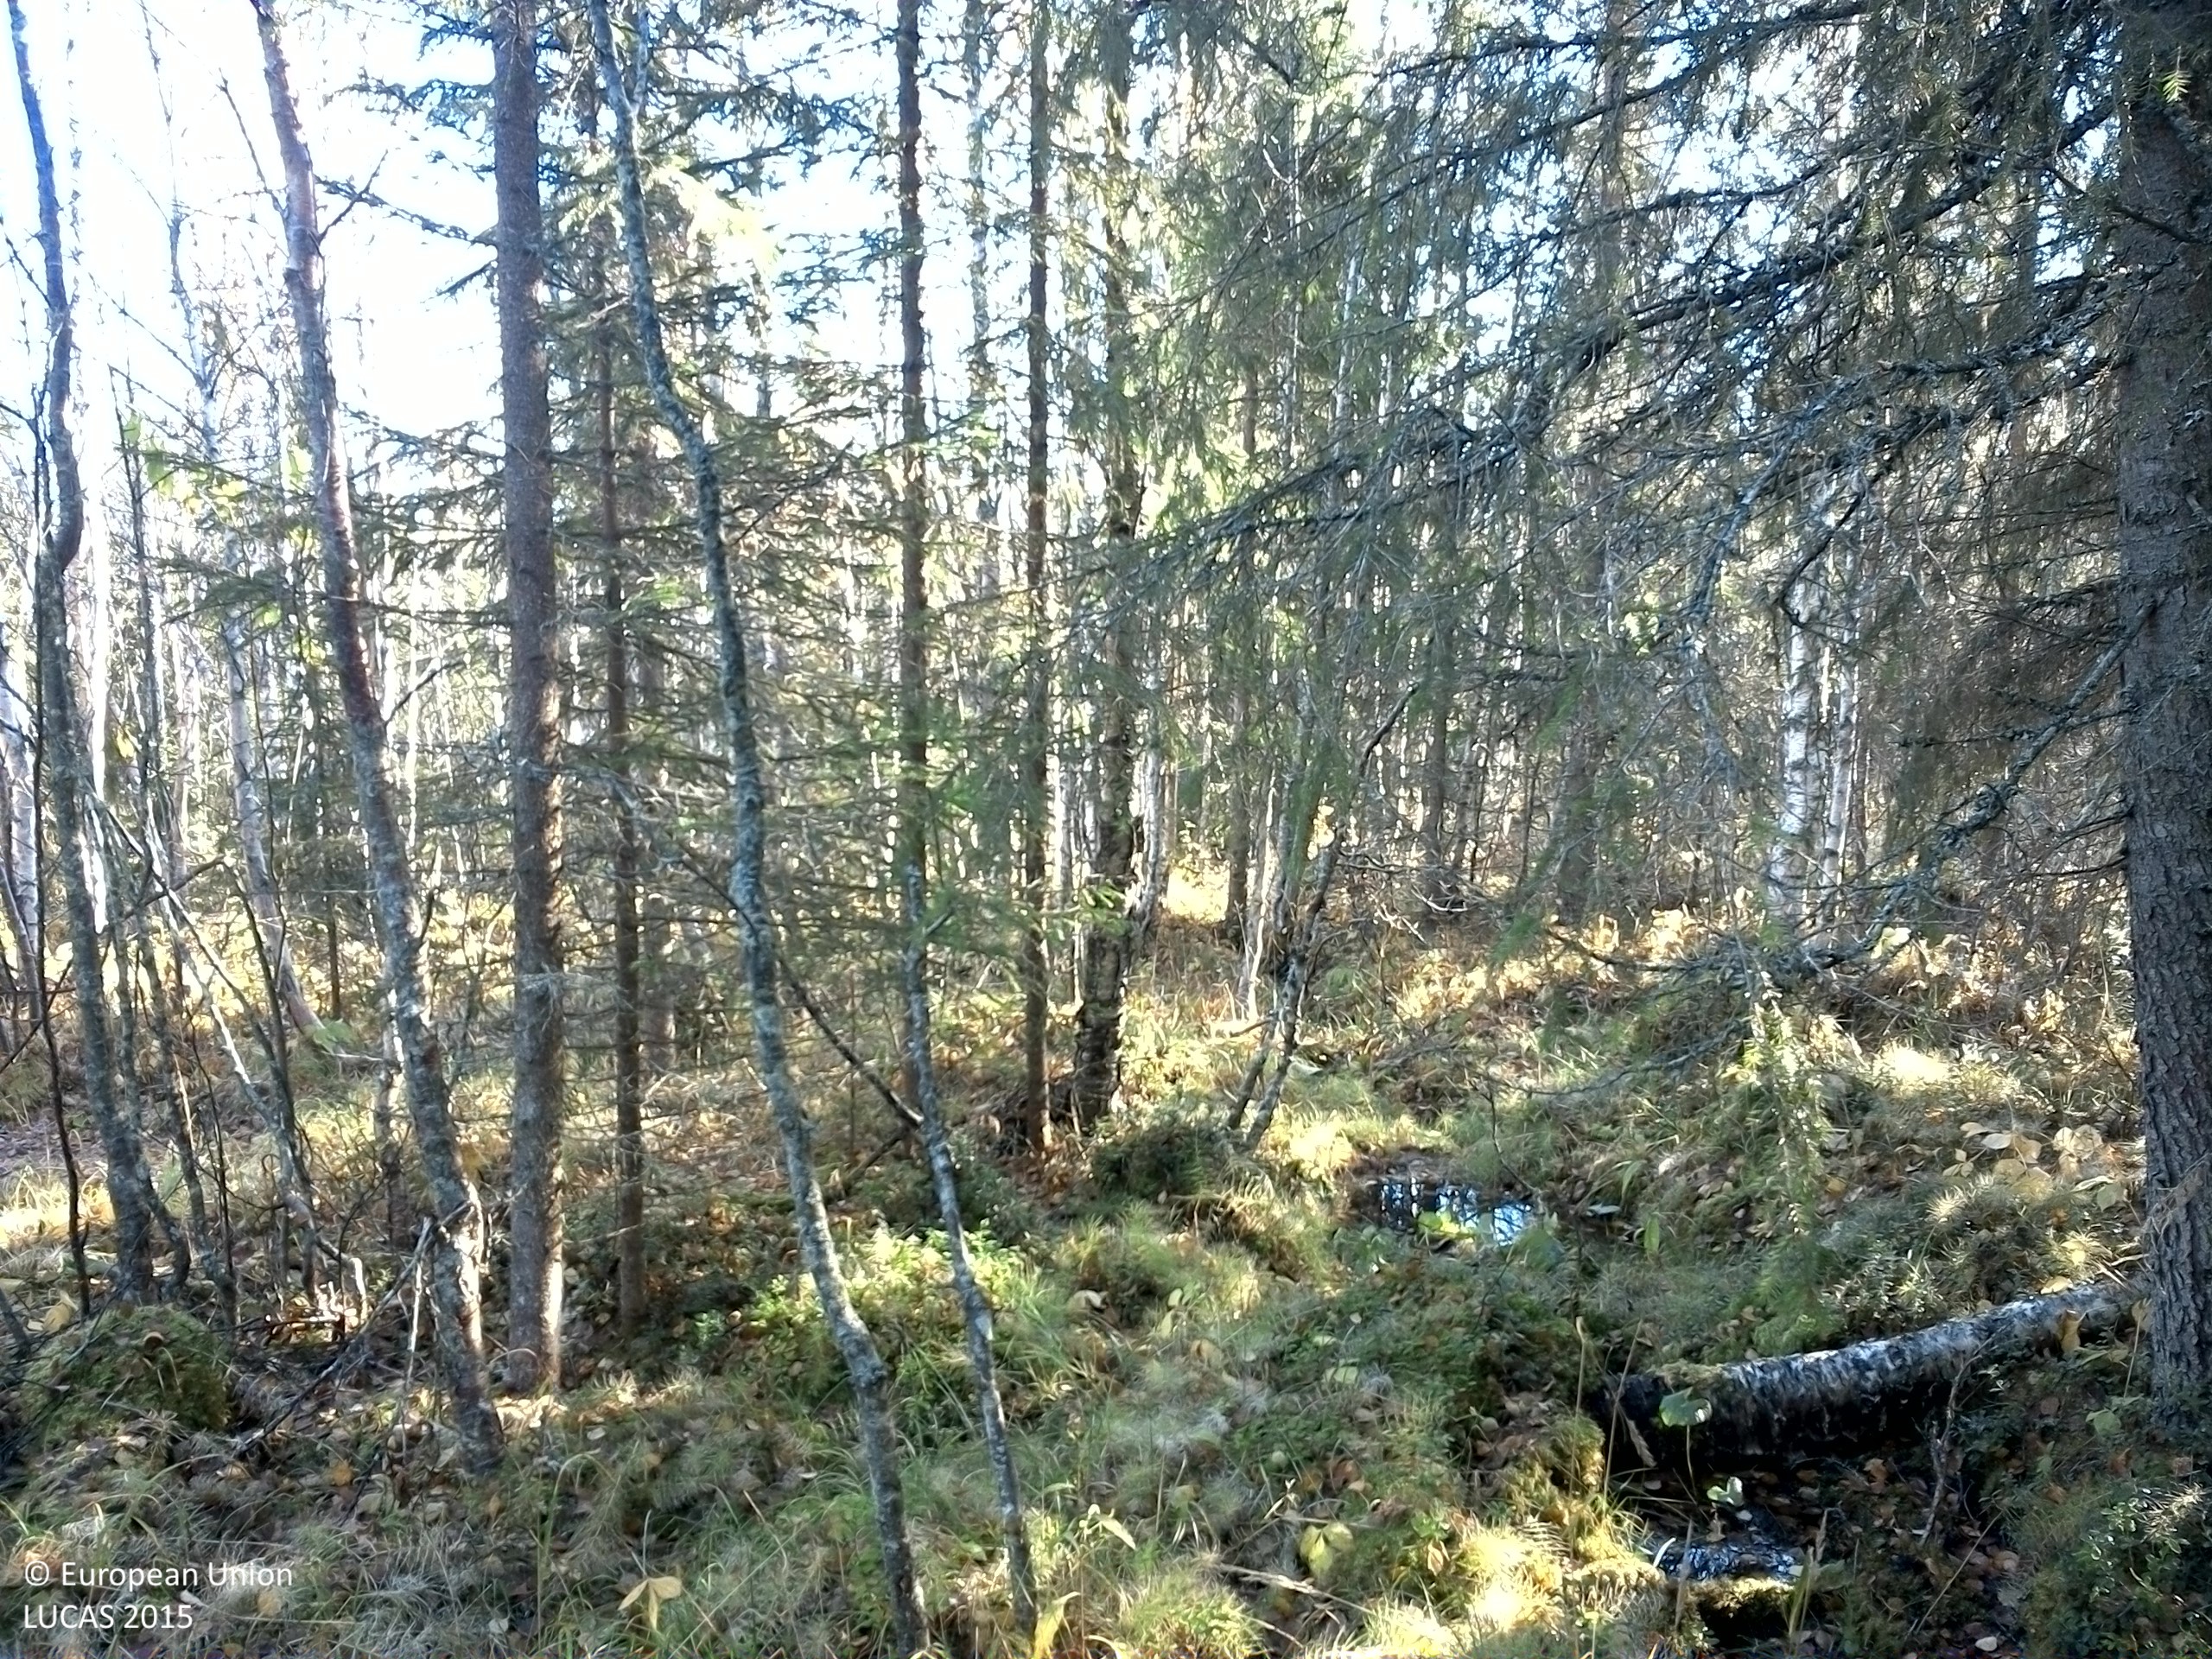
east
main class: Woodland
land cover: Spruce dominated mixed woodland
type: boreal forest
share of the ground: 50 - 75 %
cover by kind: coniferous forest trees 45 %, broadleaved forest trees 20 %, shrubs 15 %, herbaceous plants 10 %, lichens and mosses 10 %
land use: Forestry
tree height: > 5 m
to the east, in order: Spruce dominated mixed woodland; Rivers and streams; Spruce dominated mixed woodland; Spruce dominated coniferous woodland; Spruce dominated mixed woodland
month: October
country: SE
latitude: 64.4830
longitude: 15.5252
